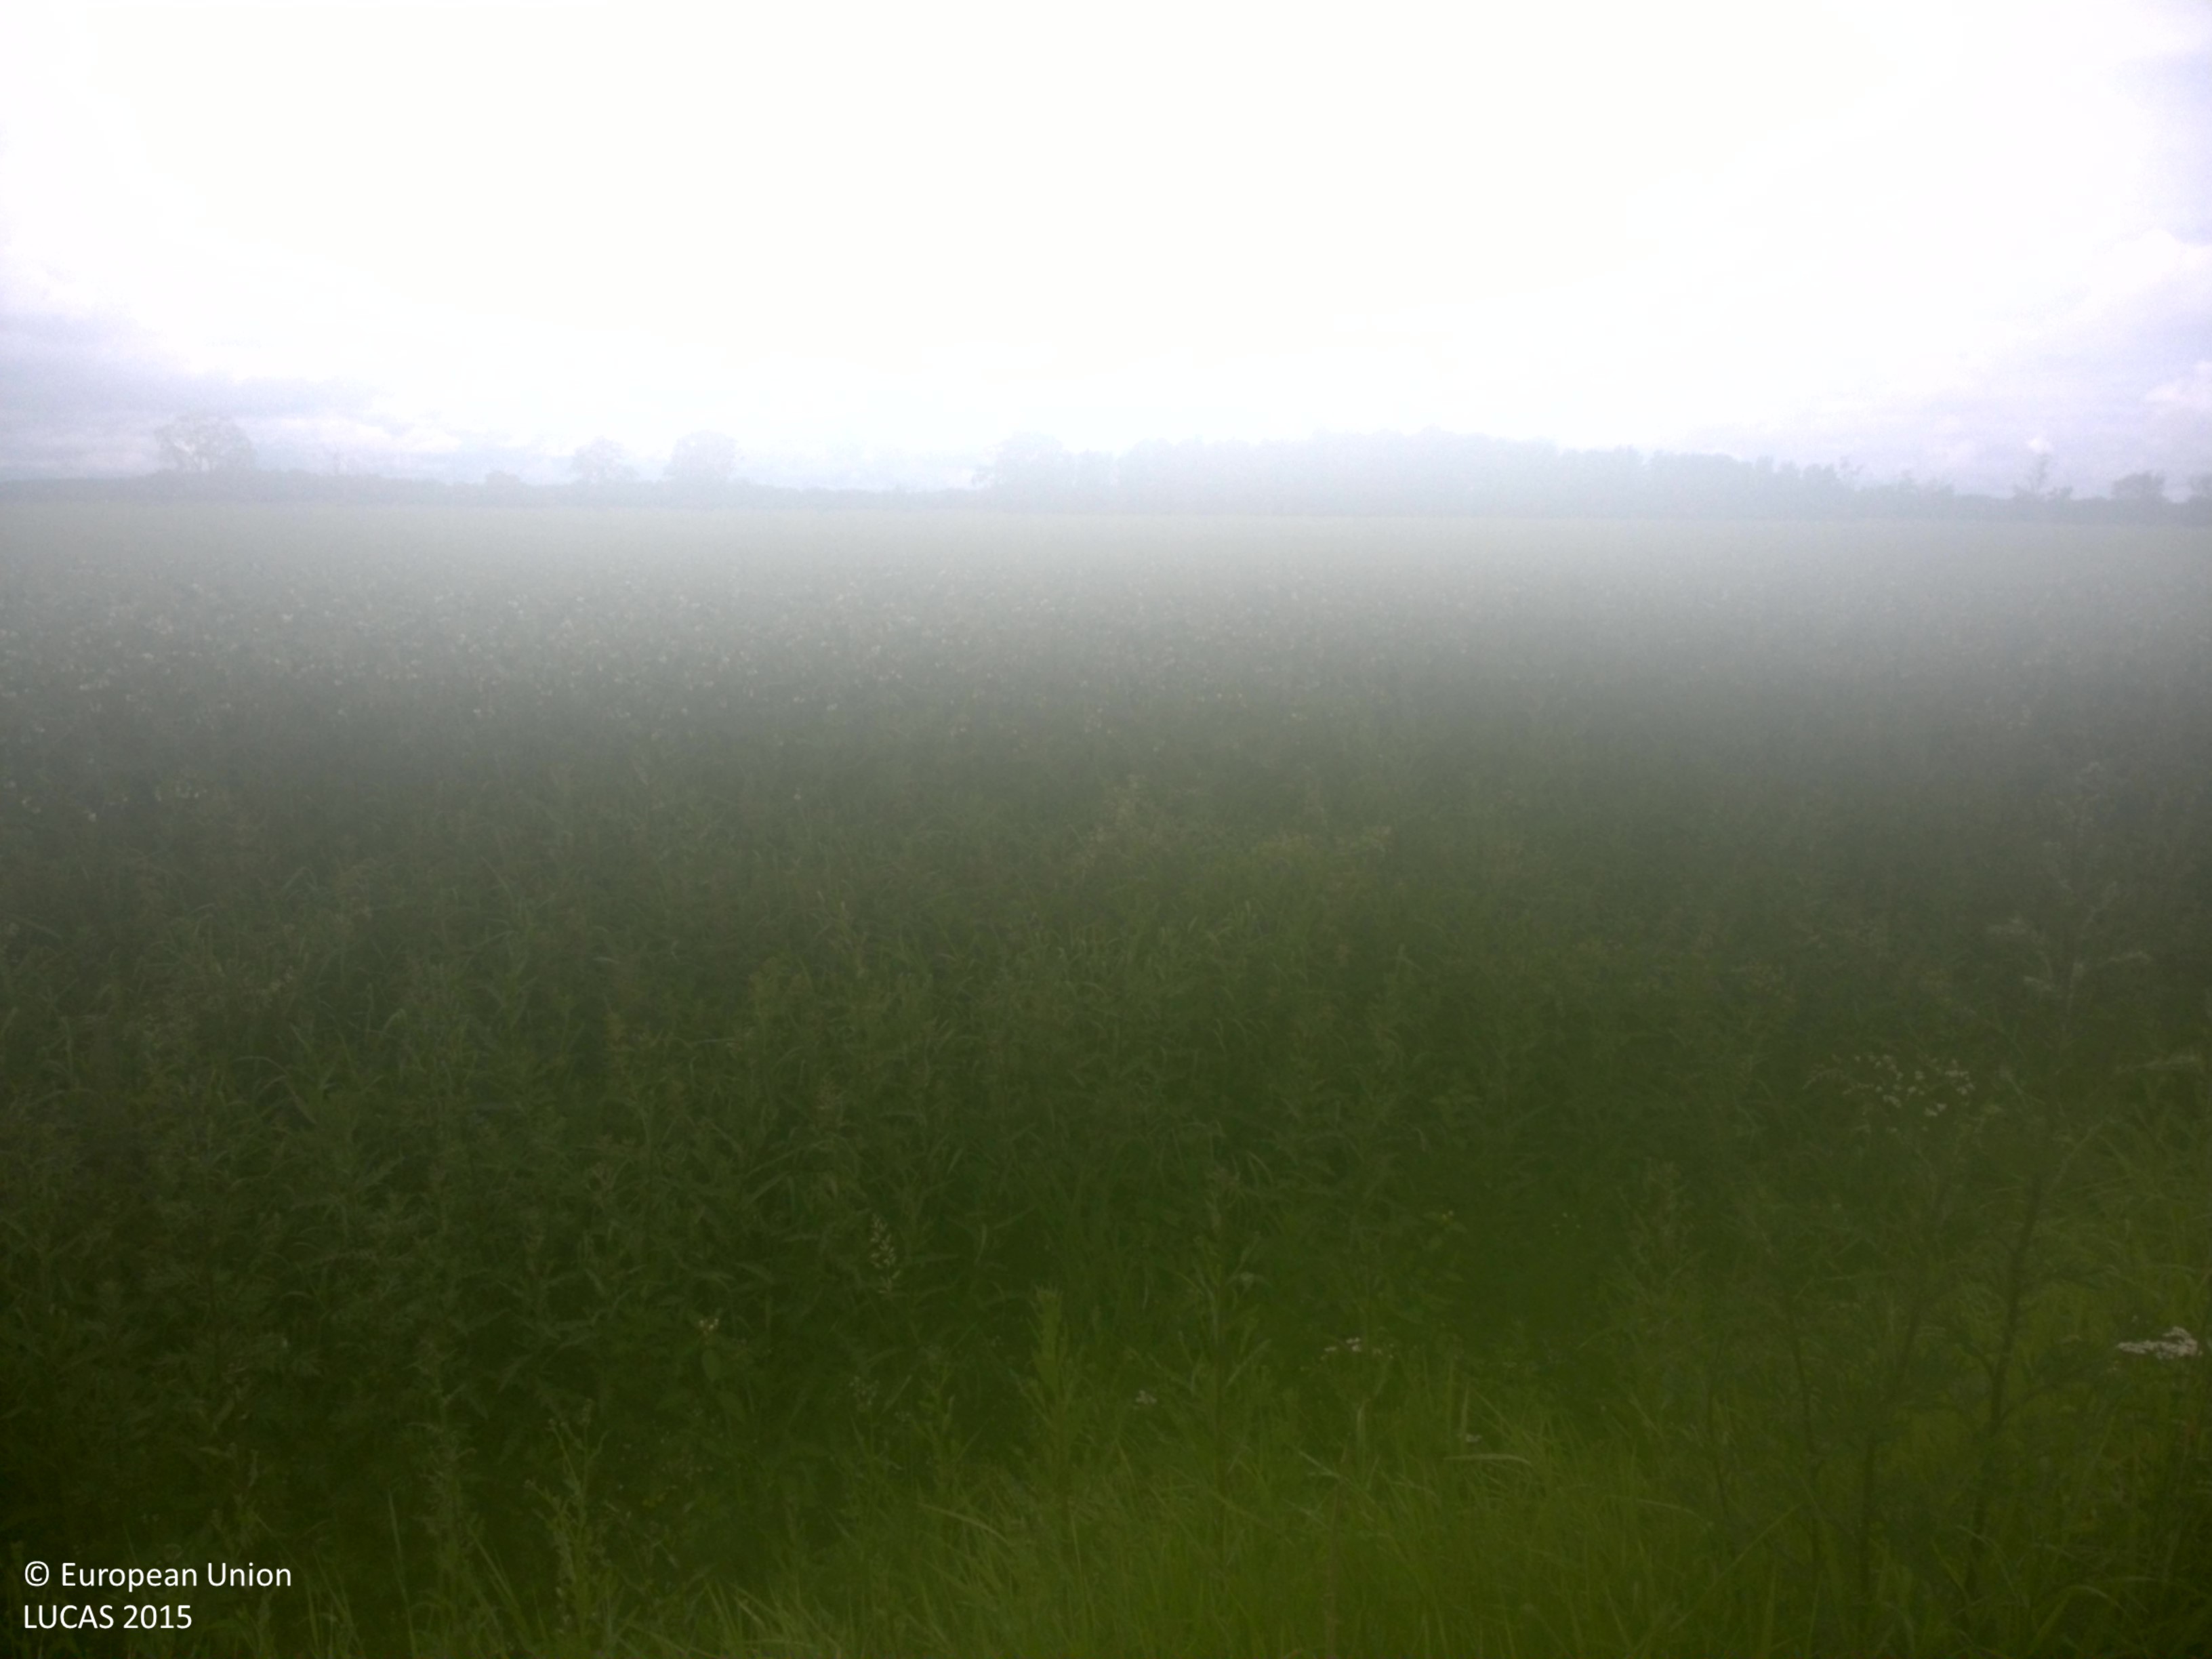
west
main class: Cropland
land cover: Common wheat
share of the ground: > 75 %
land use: Agriculture (excluding fallow land and kitchen gardens)
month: July
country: SE
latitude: 60.1032
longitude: 17.2403
